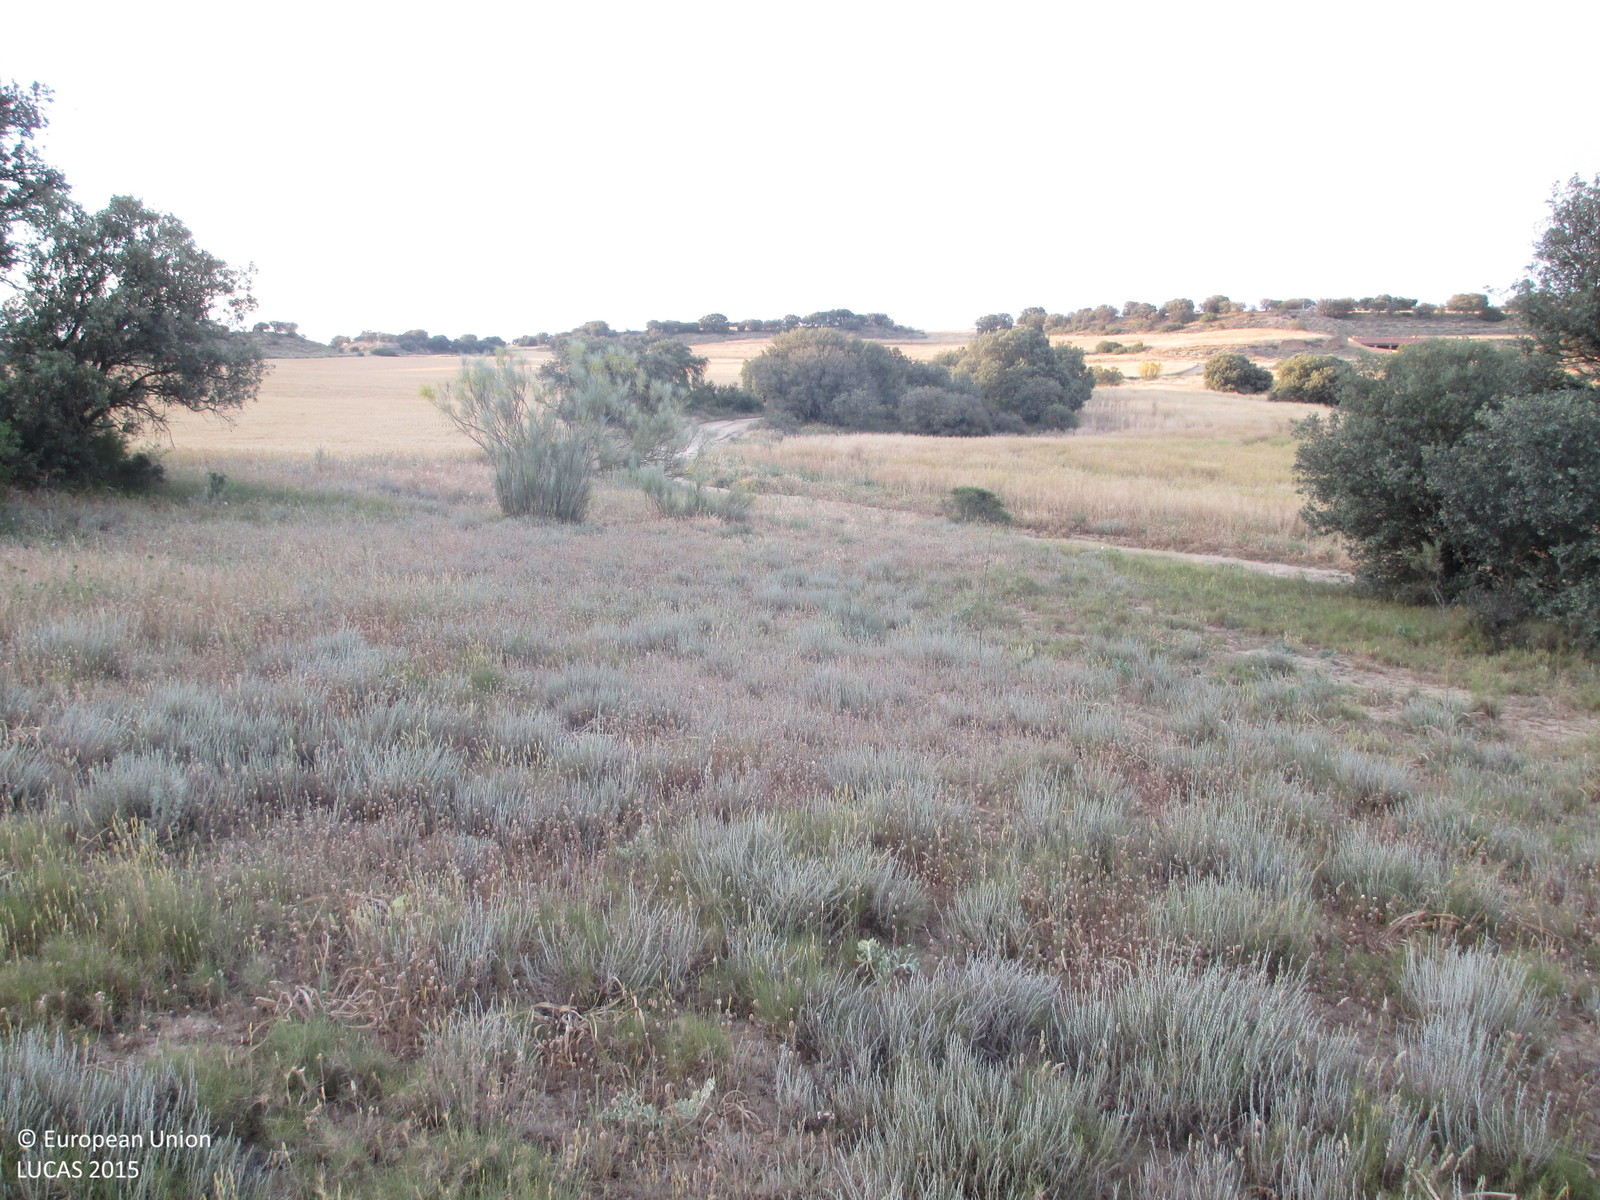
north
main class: Shrubland
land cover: Shrubland with sparse tree cover
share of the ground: > 75 %
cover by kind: shrubs 90 %, broadleaved forest trees 5 %, herbaceous plants 5 %
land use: Semi-natural and natural areas not in use
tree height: < 5 m
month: May
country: ES
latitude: 41.9748
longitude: -0.1931
